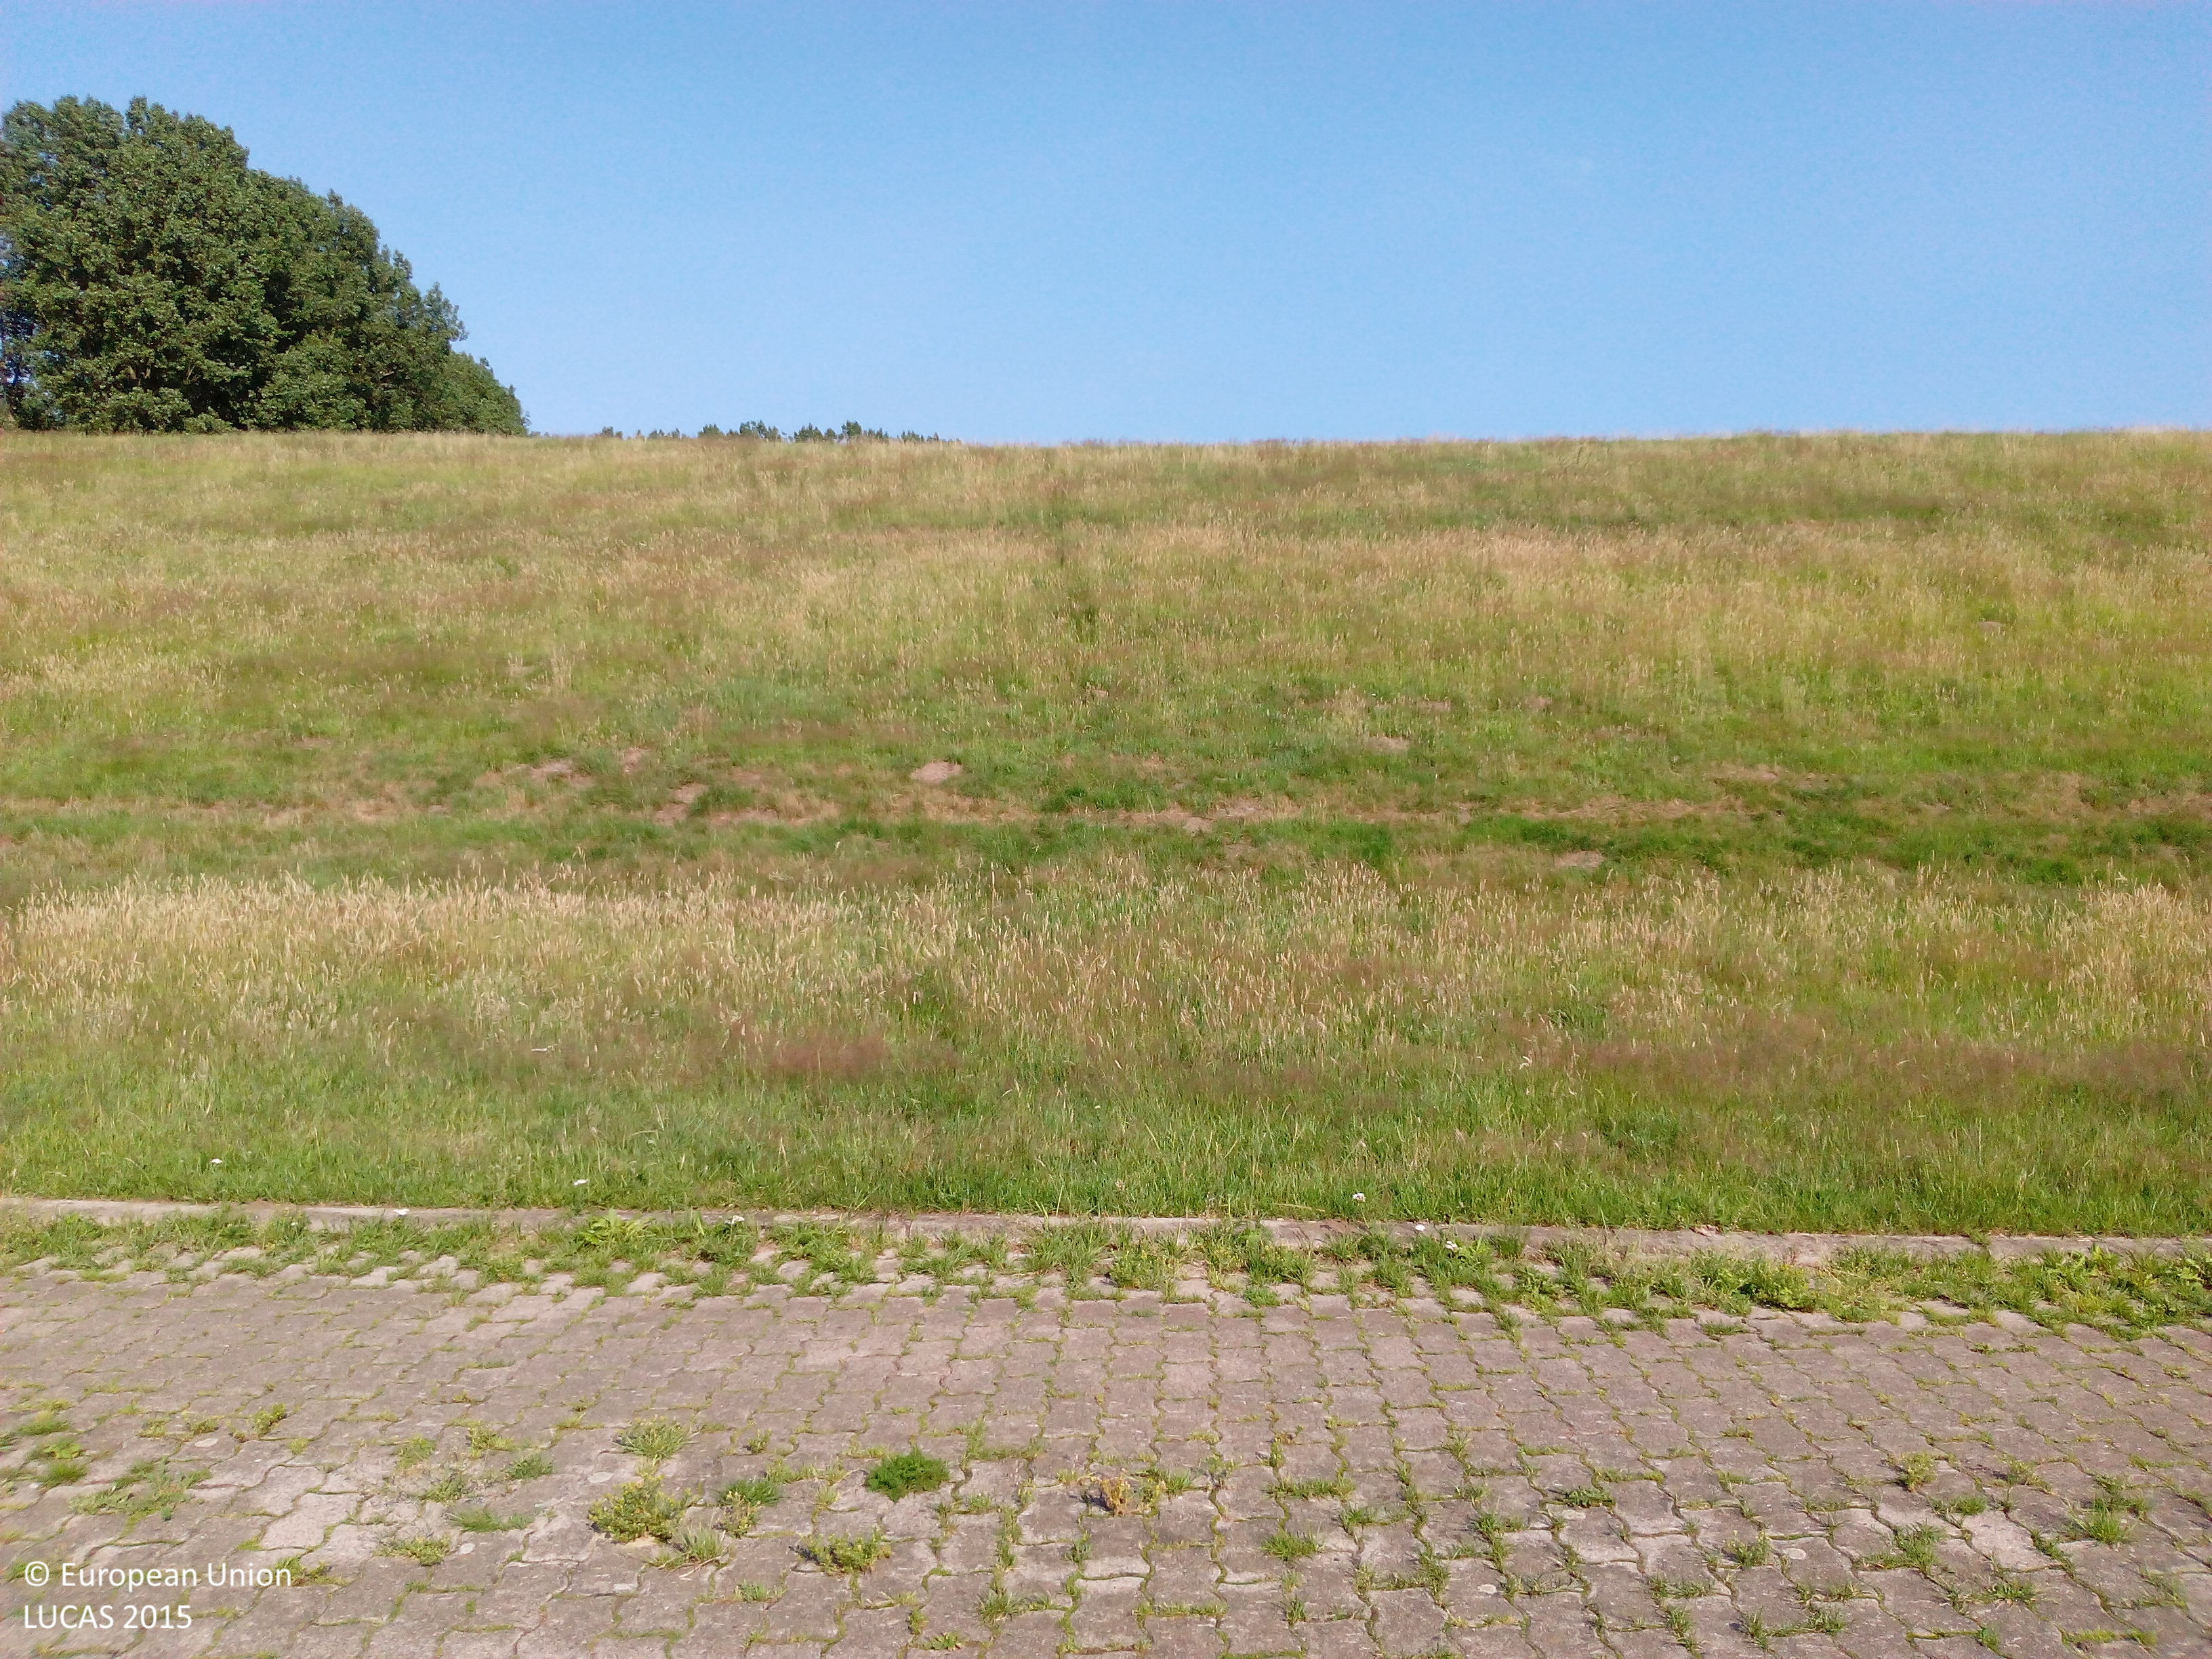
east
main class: Grassland
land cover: Spontaneously vegetated surfaces
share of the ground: > 75 %
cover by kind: herbaceous plants 100 %
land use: Agriculture (excluding fallow land and kitchen gardens)
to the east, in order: Spontaneously vegetated surfaces; Maize; Fences; Grassland without tree/shrub cover; Inland fresh running water; Grassland without tree/shrub cover; Tracks; Grassland without tree/shrub cover; Tracks; Grassland without tree/shrub cover; Tracks; Grassland without tree/shrub cover; Fences; Grassland without tree/shrub cover
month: July
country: DE
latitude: 52.5042
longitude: 7.9822
